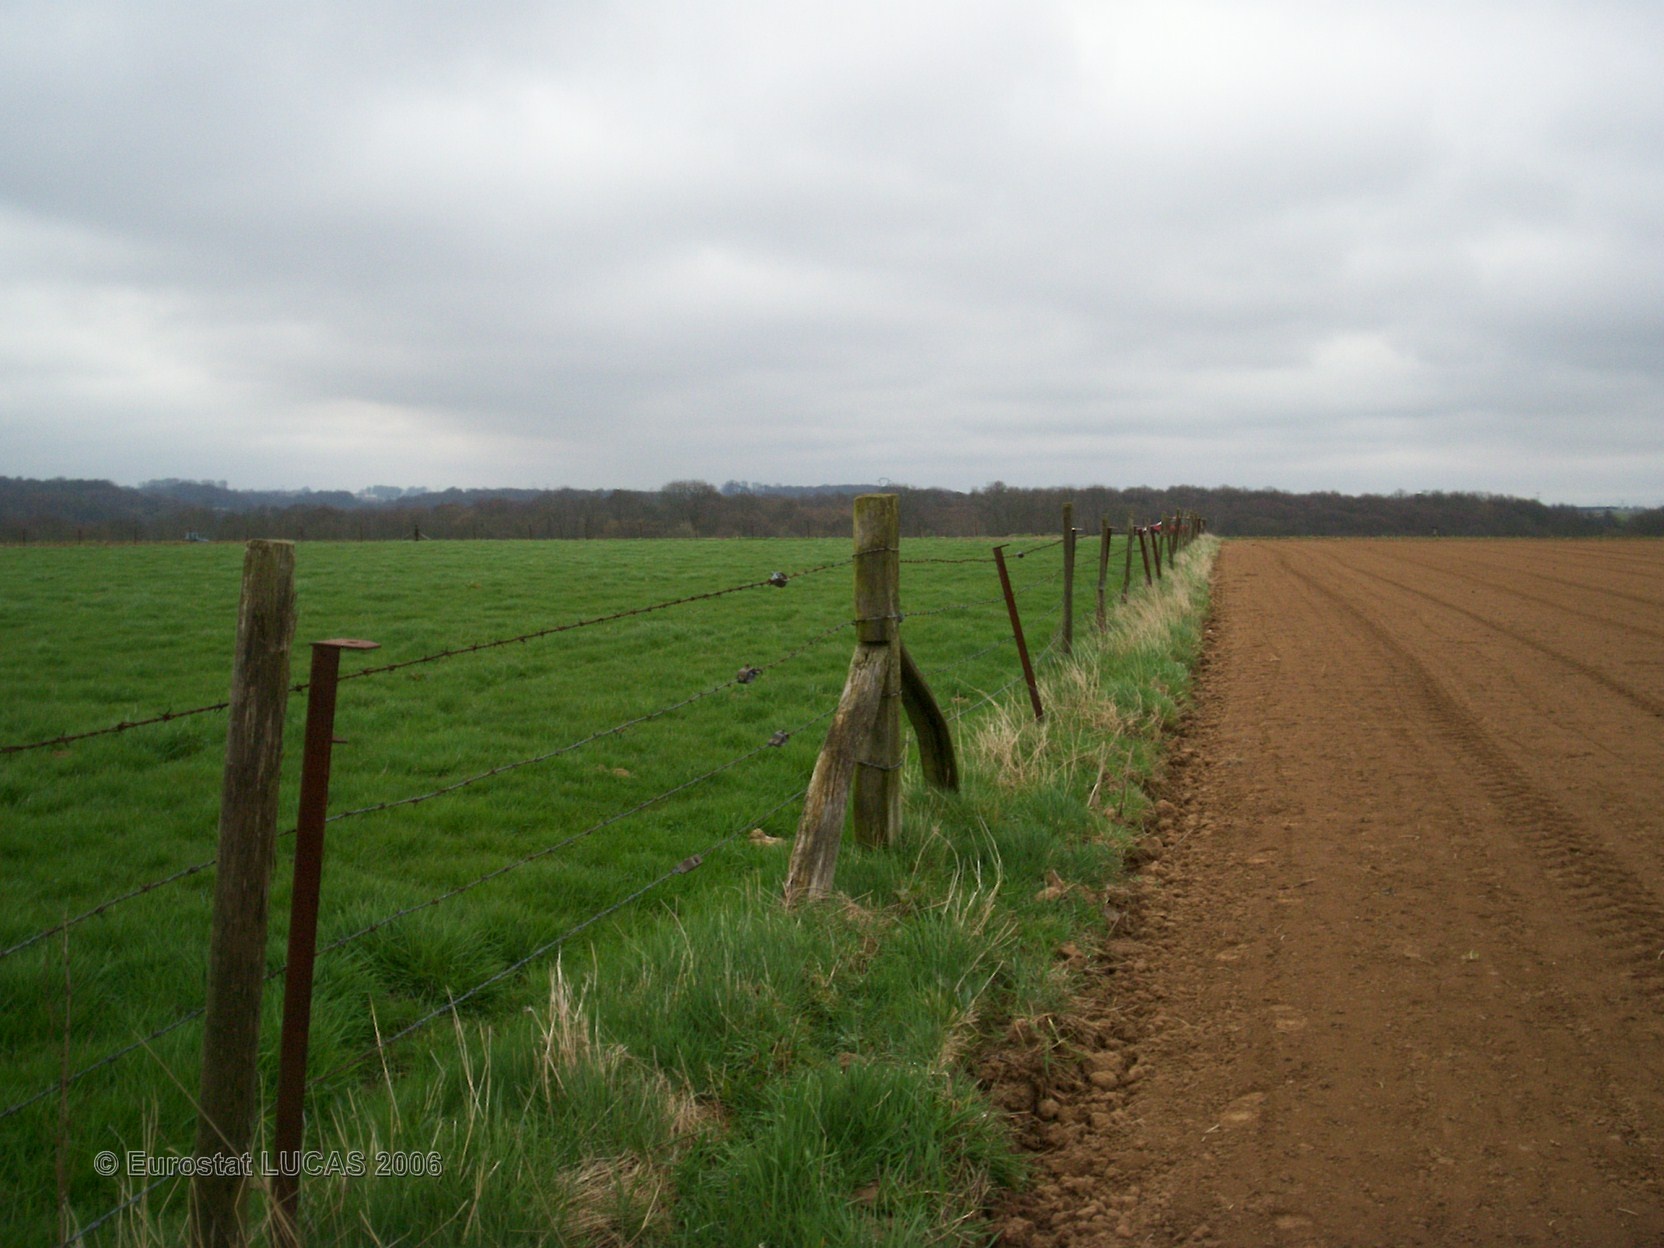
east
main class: Grassland
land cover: Grassland without tree/shrub cover
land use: Agriculture (excluding fallow land and kitchen gardens)
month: April
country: FR
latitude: 49.5145
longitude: 0.9302
